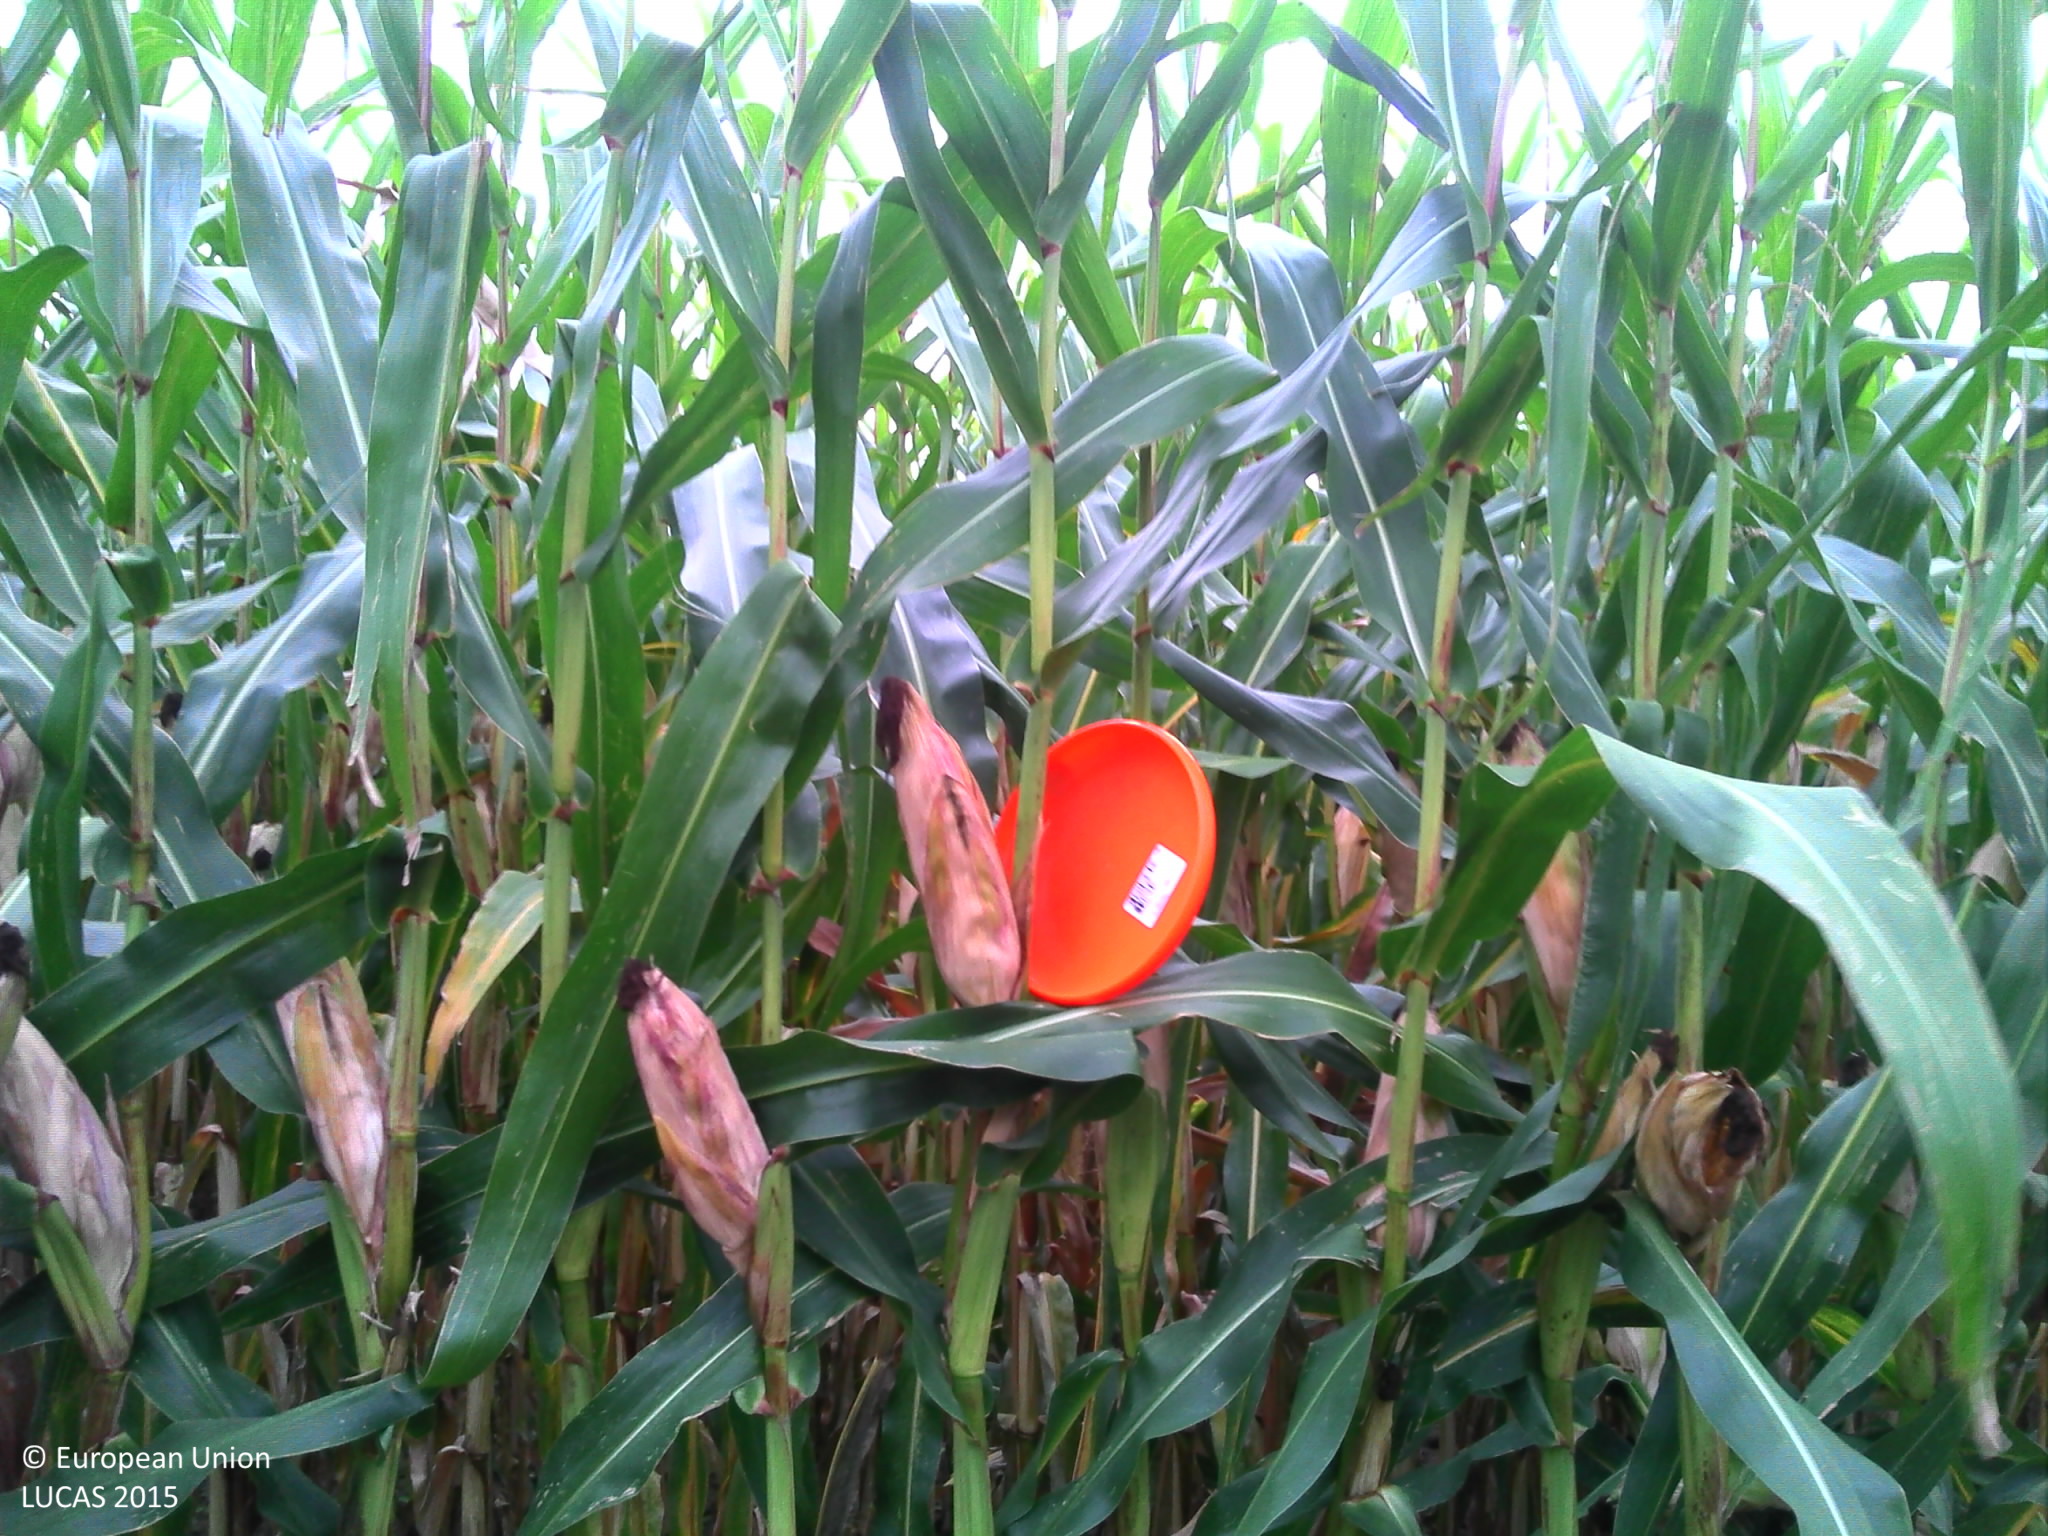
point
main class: Cropland
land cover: Maize
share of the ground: > 75 %
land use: Agriculture (excluding fallow land and kitchen gardens)
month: September
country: FR
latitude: 48.2848
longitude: 7.4808
